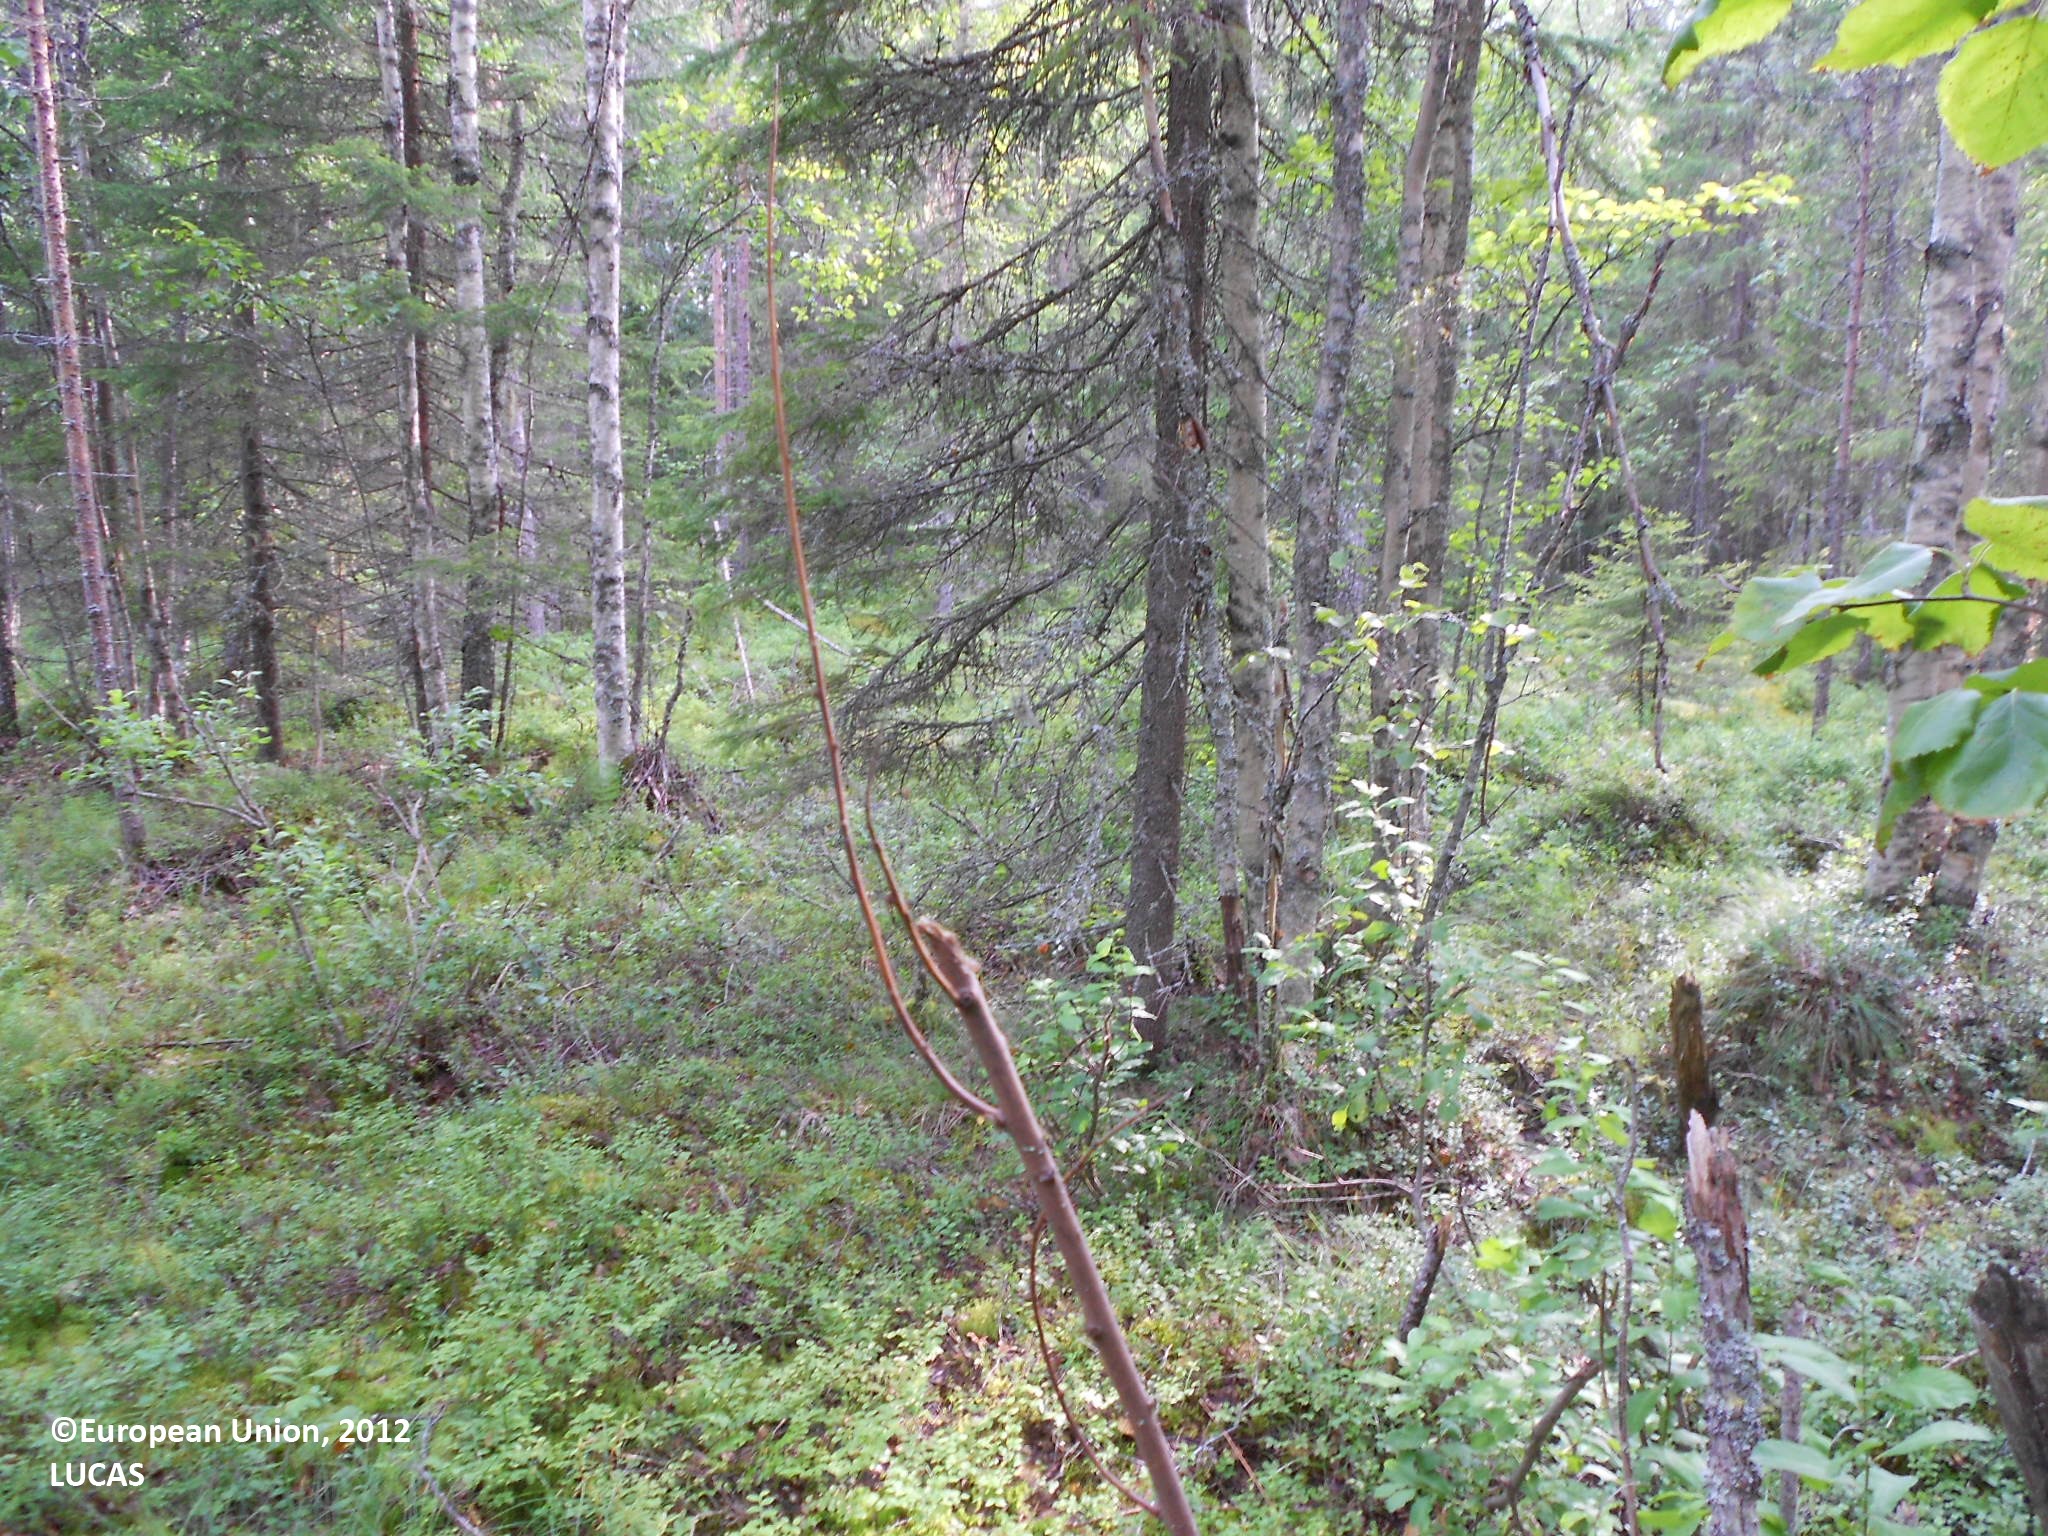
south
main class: Woodland
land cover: Pine dominated coniferous woodland
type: boreal forest
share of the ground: 50 - 75 %
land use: Forestry
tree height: > 5 m
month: August
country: FI
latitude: 63.3724
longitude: 29.0708
